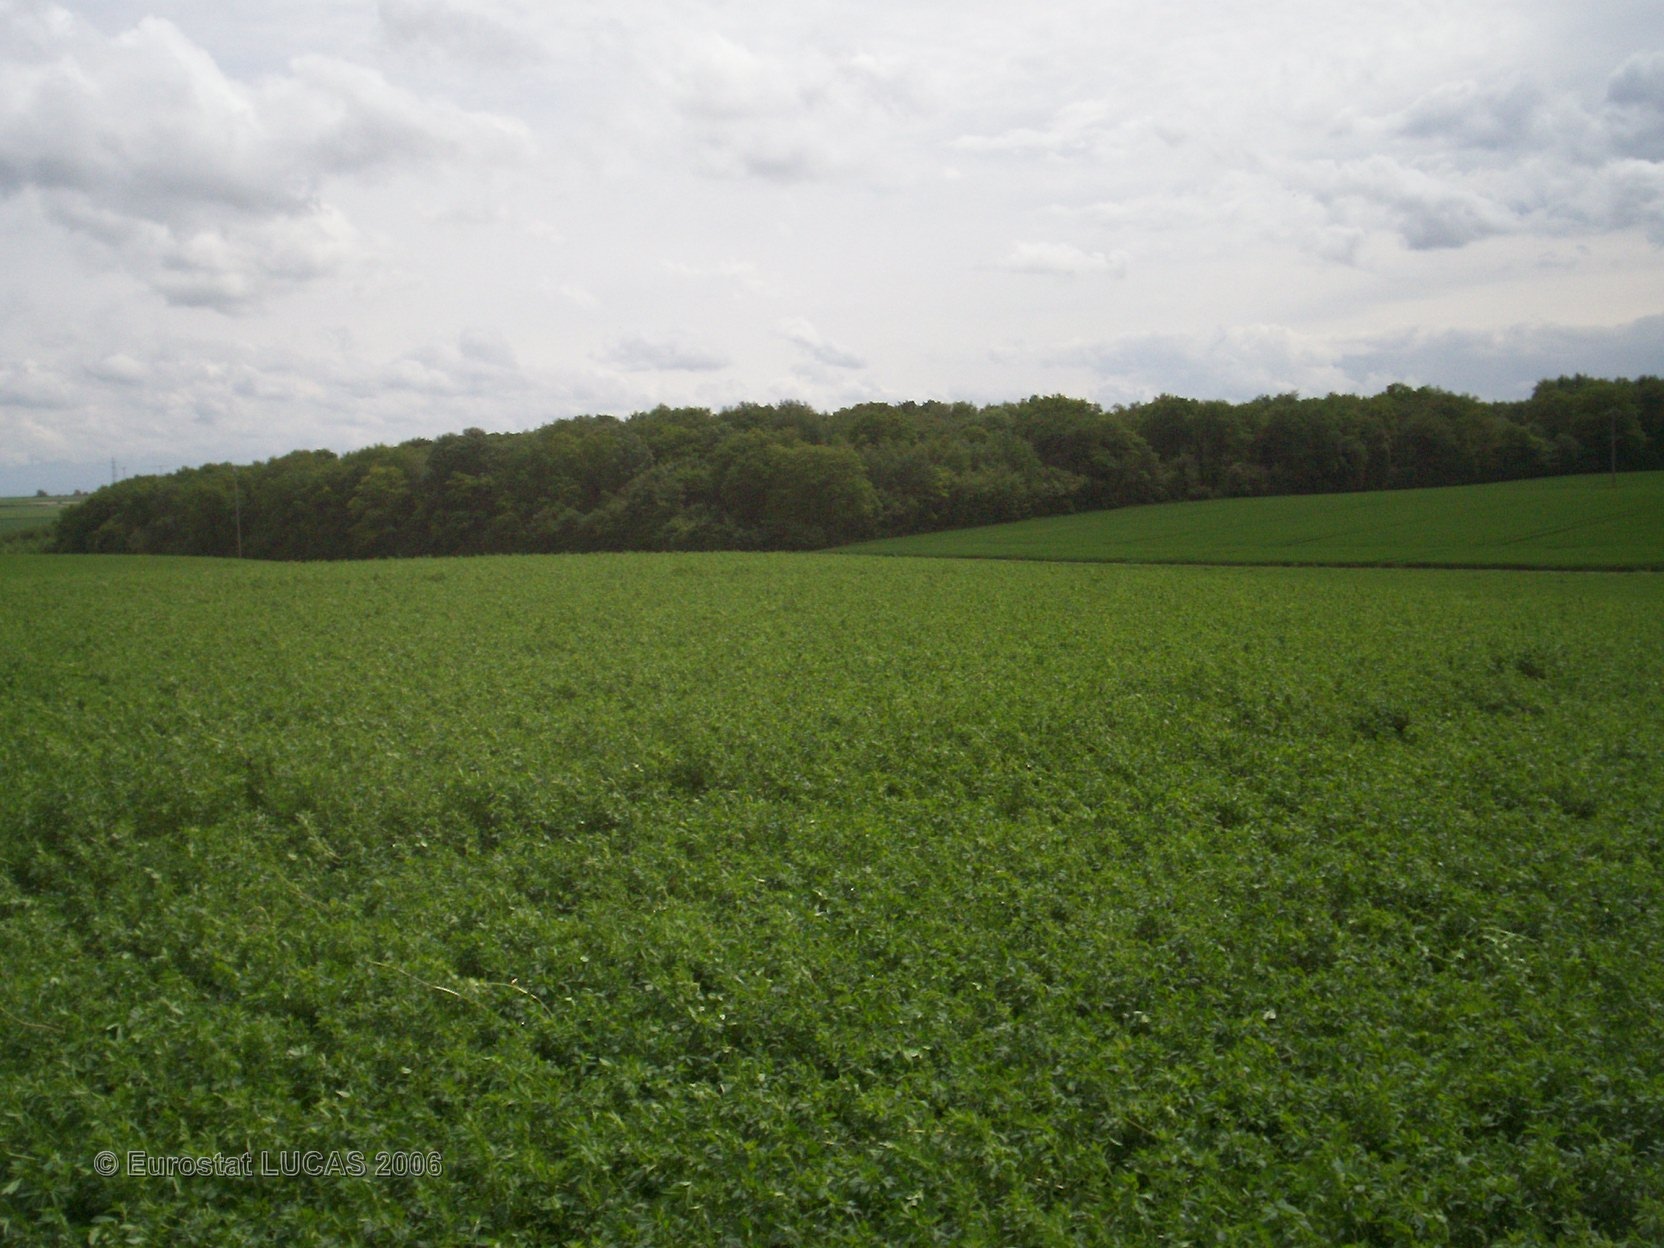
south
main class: Cropland
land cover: Lucerne
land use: Agriculture (excluding fallow land and kitchen gardens)
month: May
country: FR
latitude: 49.4660
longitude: 4.3246
